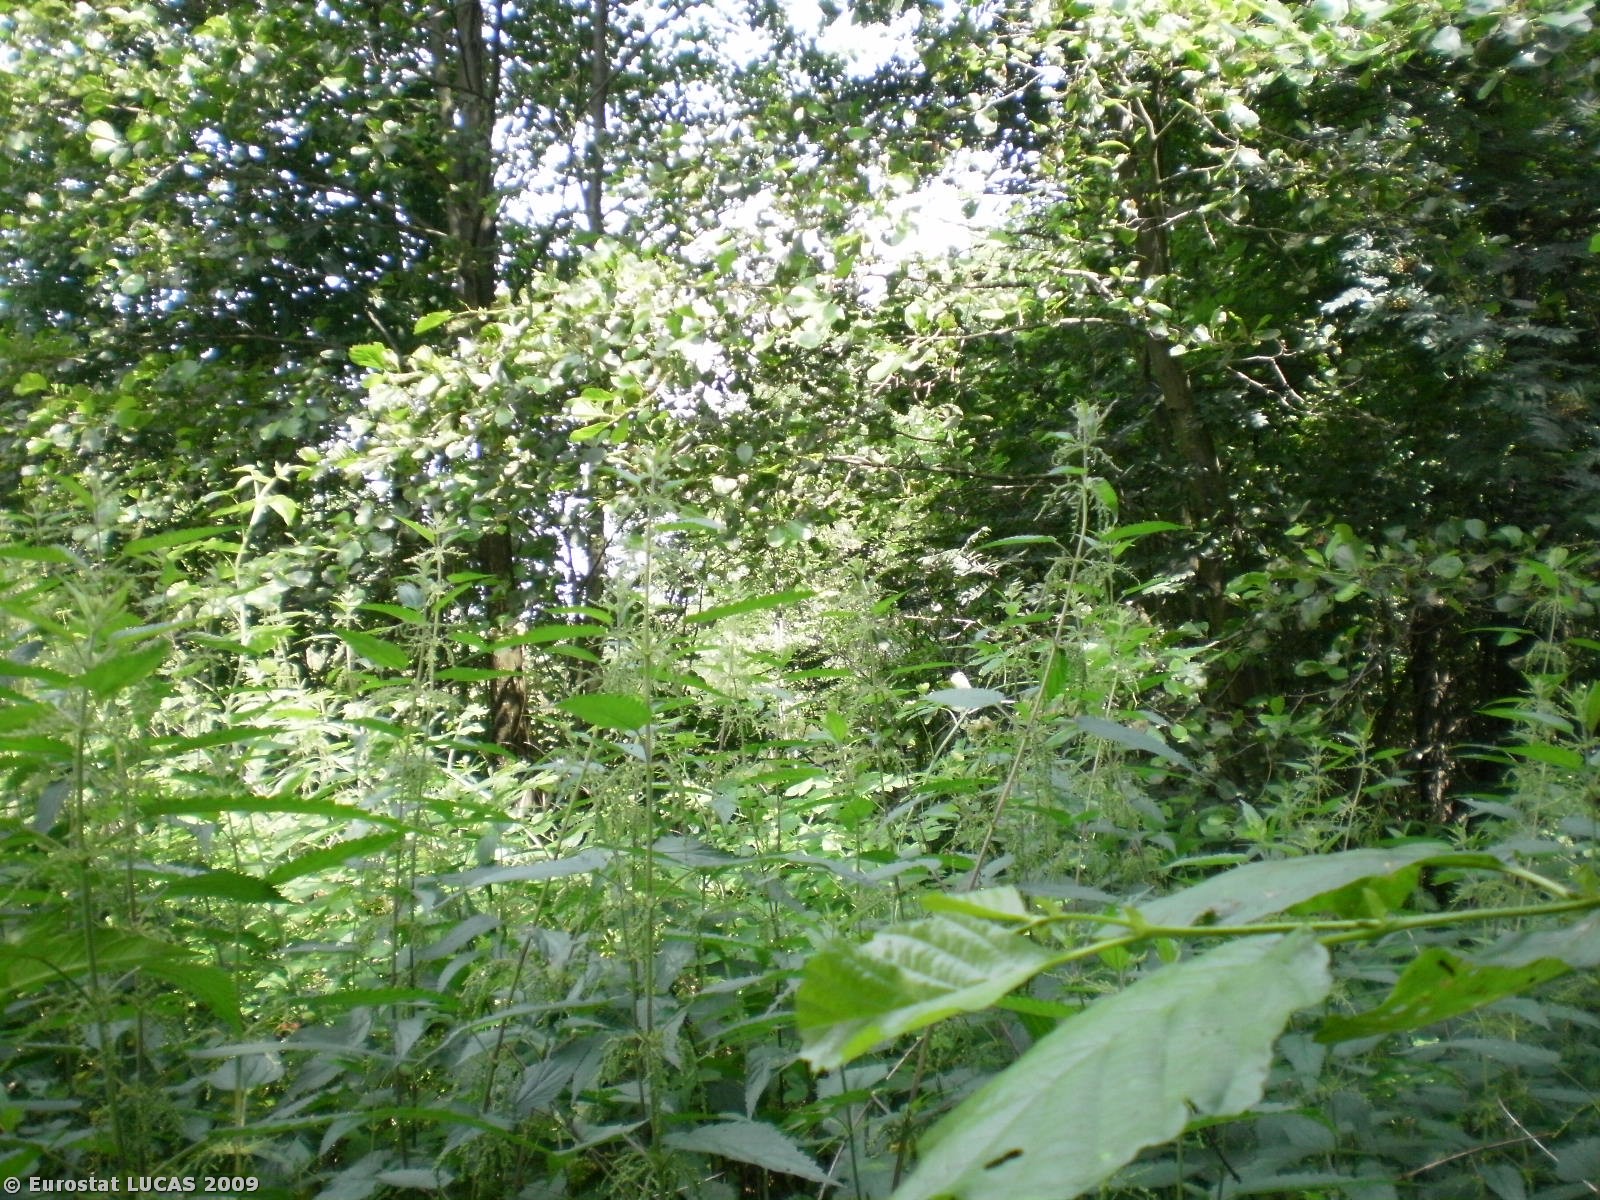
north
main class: Woodland
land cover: Broadleaved woodland
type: mire and swamp forests
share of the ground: > 75 %
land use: Forestry
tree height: > 5 m
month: July
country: PL
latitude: 54.0379
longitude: 20.0020
